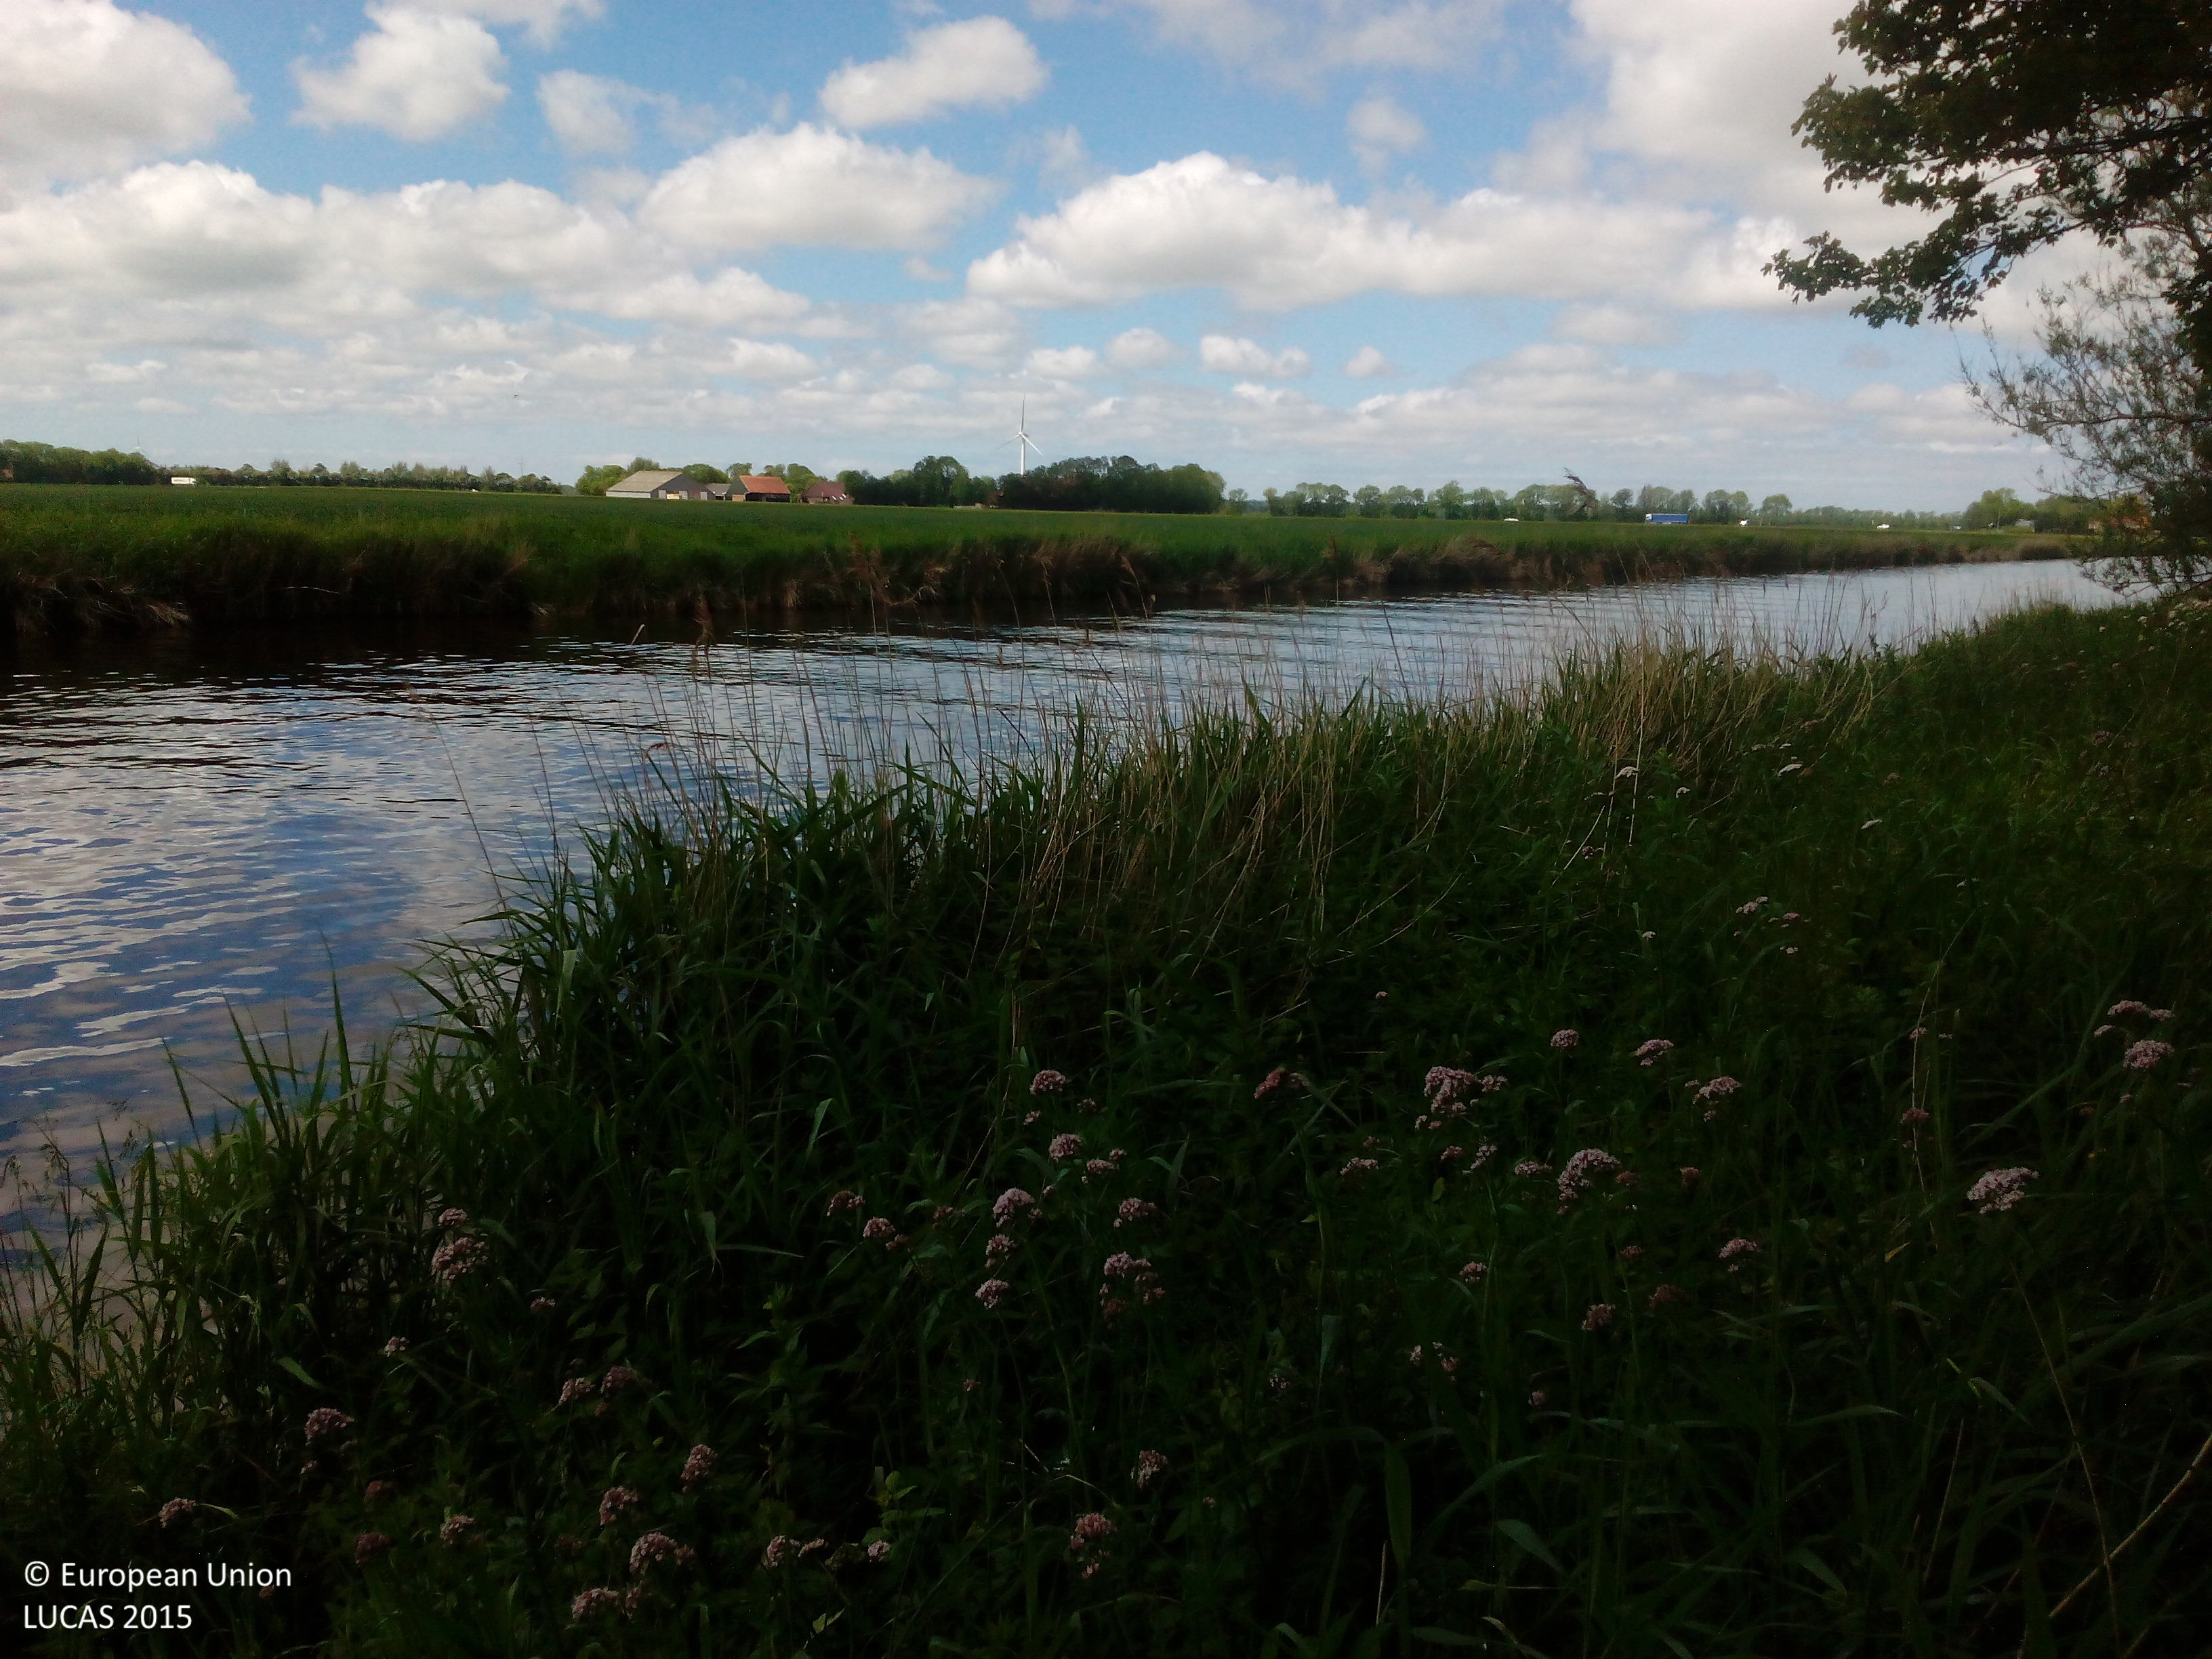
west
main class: Cropland
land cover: Arable land (only in case pi)
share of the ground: > 75 %
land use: Agriculture (excluding fallow land and kitchen gardens)
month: June
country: NL
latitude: 52.7945
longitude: 4.9998
